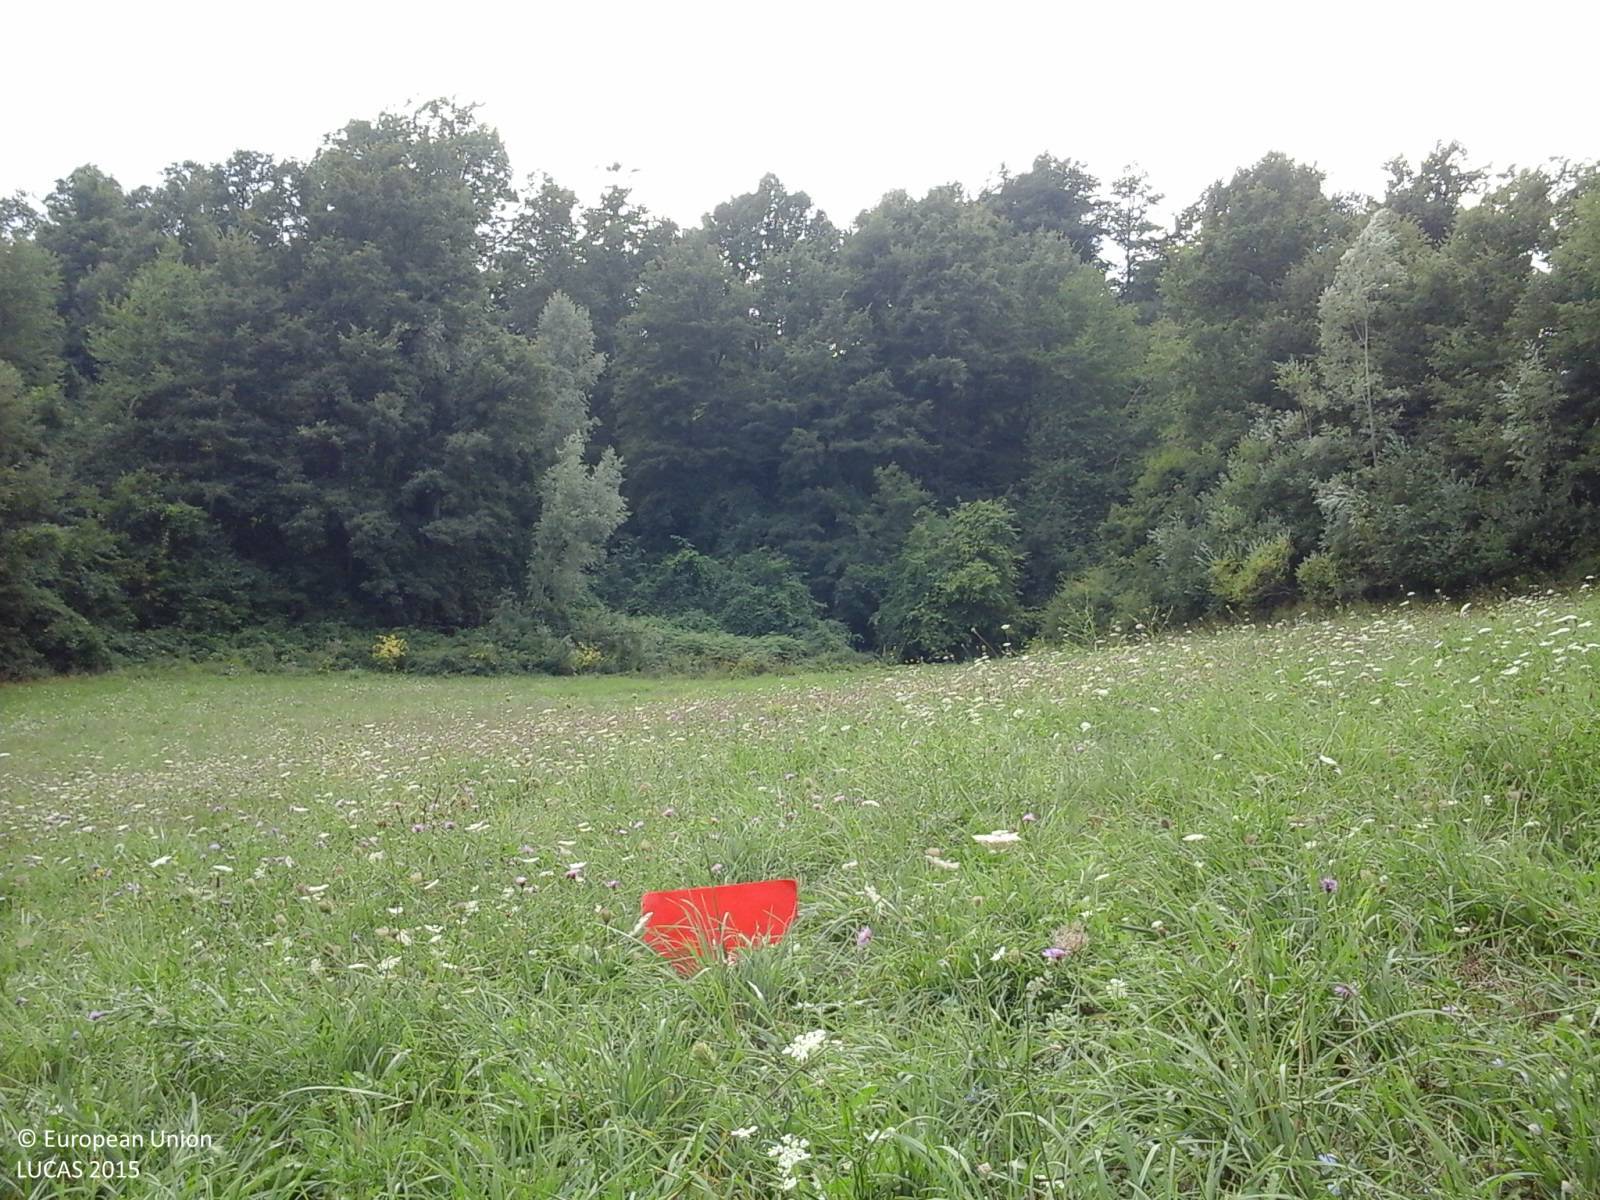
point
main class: Grassland
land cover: Grassland without tree/shrub cover
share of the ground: > 75 %
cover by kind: herbaceous plants 100 %
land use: Agriculture (excluding fallow land and kitchen gardens)
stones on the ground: < 10 %
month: August
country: IT
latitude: 43.7154
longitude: 12.1170
